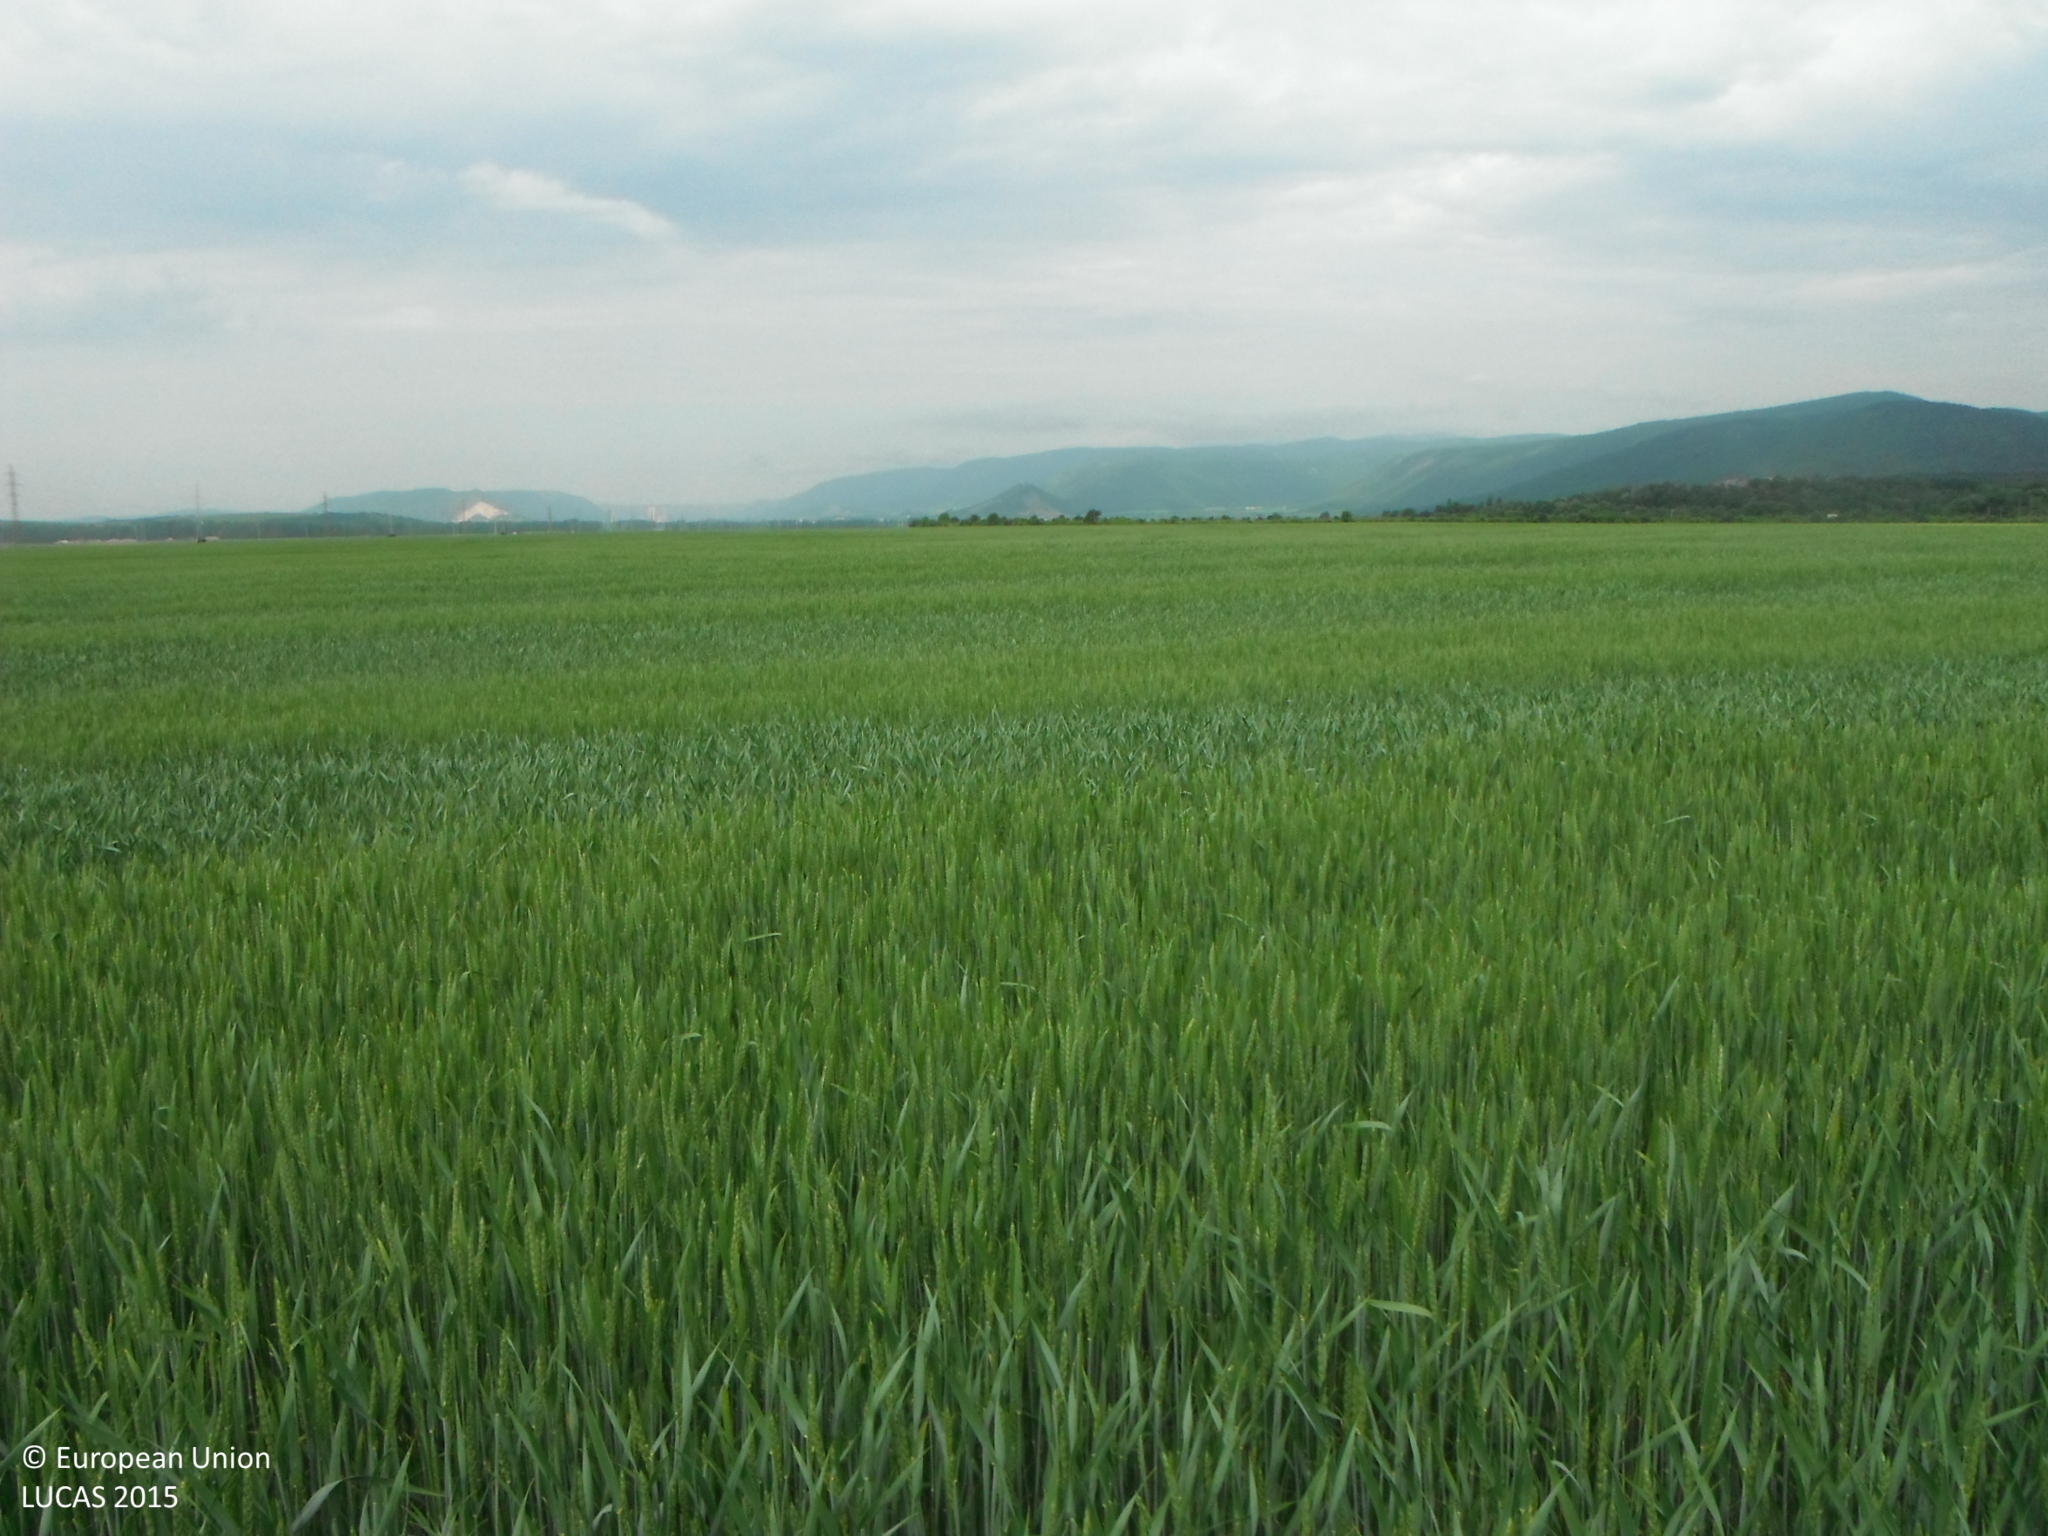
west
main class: Cropland
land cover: Common wheat
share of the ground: > 75 %
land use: Agriculture (excluding fallow land and kitchen gardens)
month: May
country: SK
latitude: 48.5989
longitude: 20.9838
